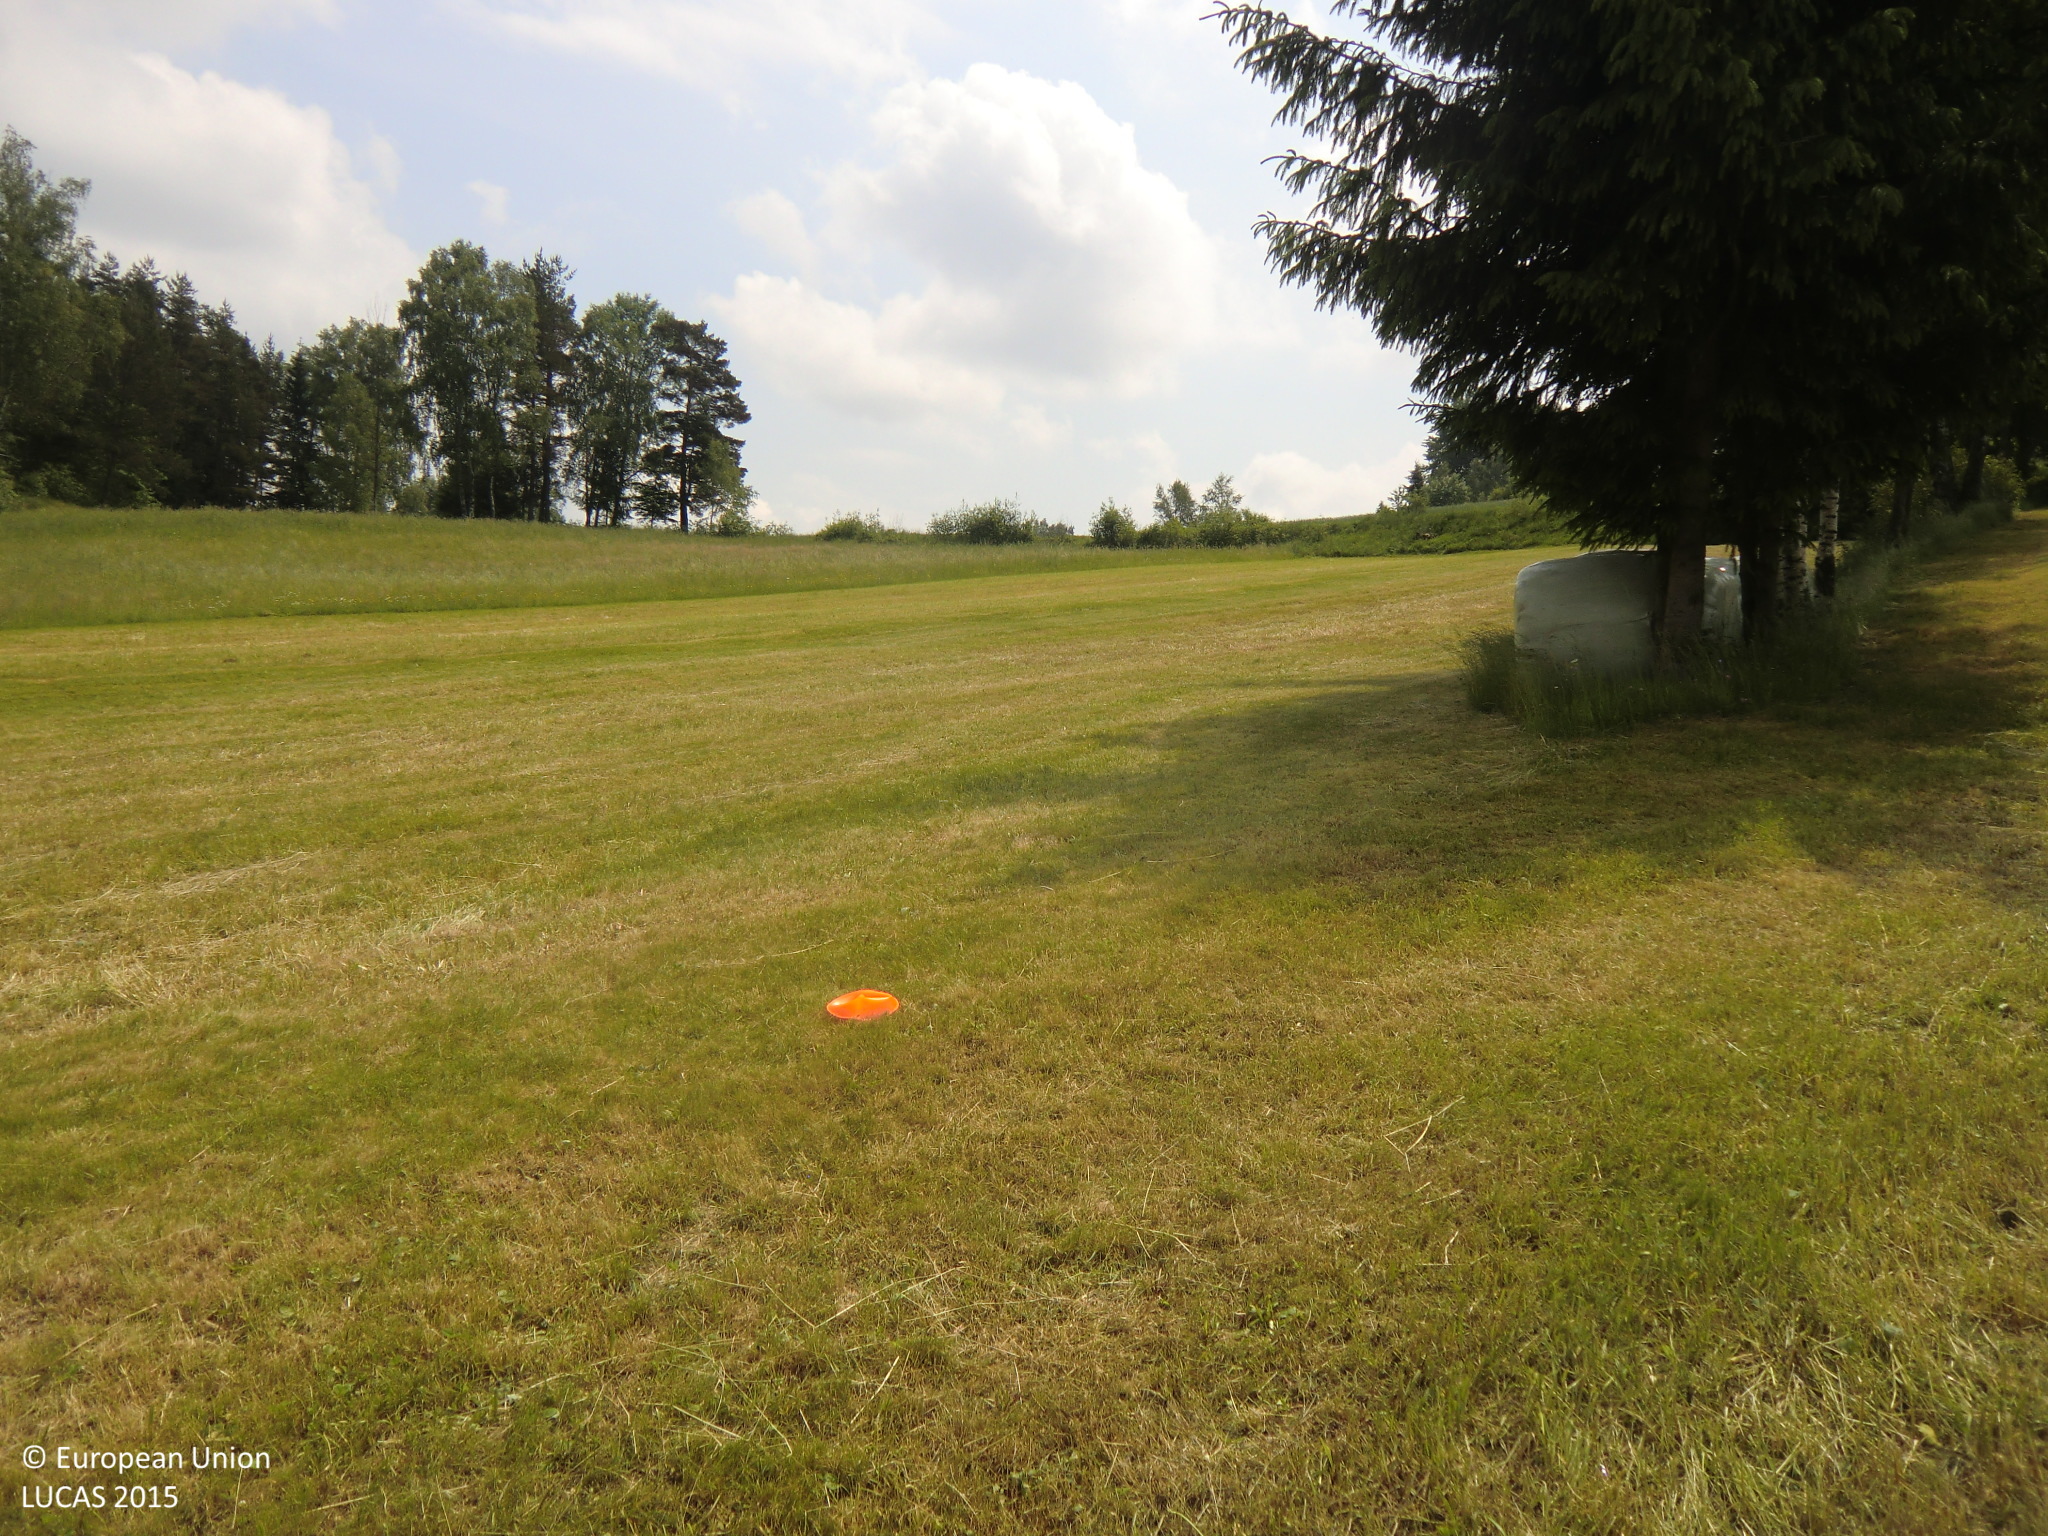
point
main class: Grassland
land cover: Grassland without tree/shrub cover
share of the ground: > 75 %
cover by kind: herbaceous plants 100 %
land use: Agriculture (excluding fallow land and kitchen gardens)
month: June
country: AT
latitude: 48.6386
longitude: 14.8734
